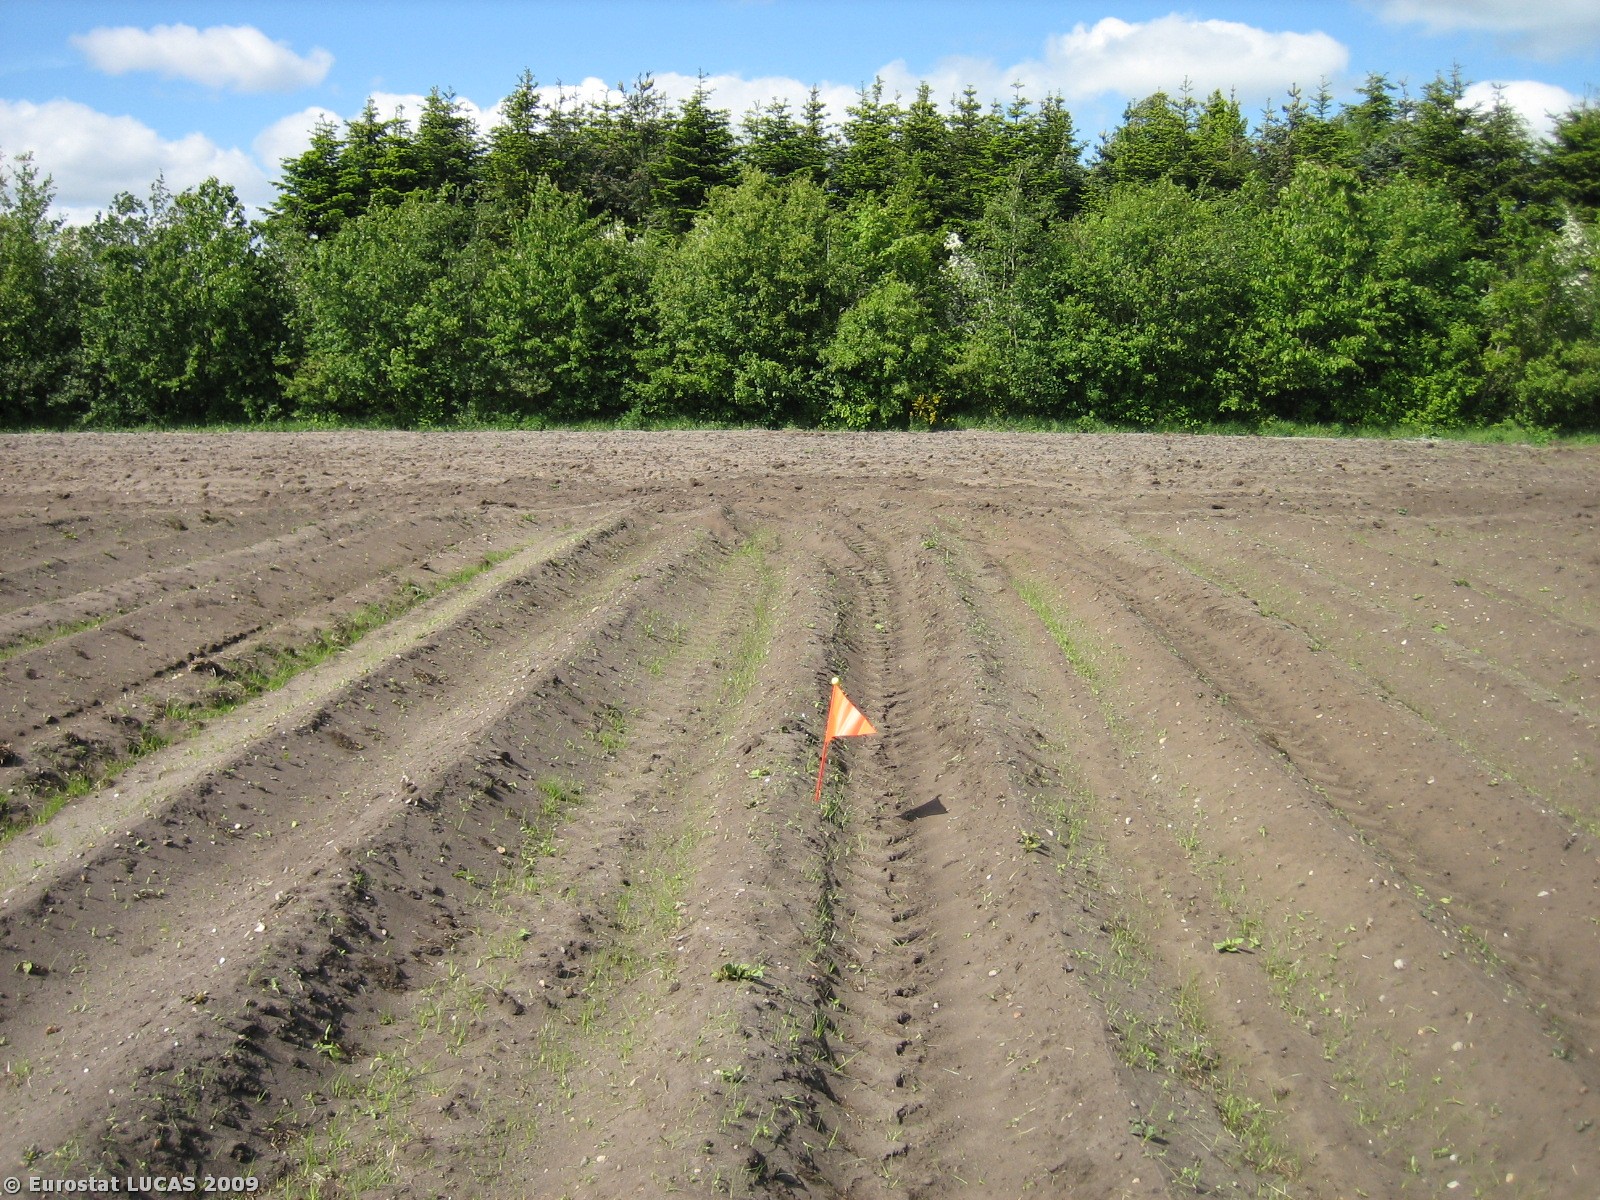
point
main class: Cropland
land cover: Potatoes
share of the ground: < 10 %
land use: Agriculture (excluding fallow land and kitchen gardens)
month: May
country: DK
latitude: 56.0040
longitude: 8.9908
